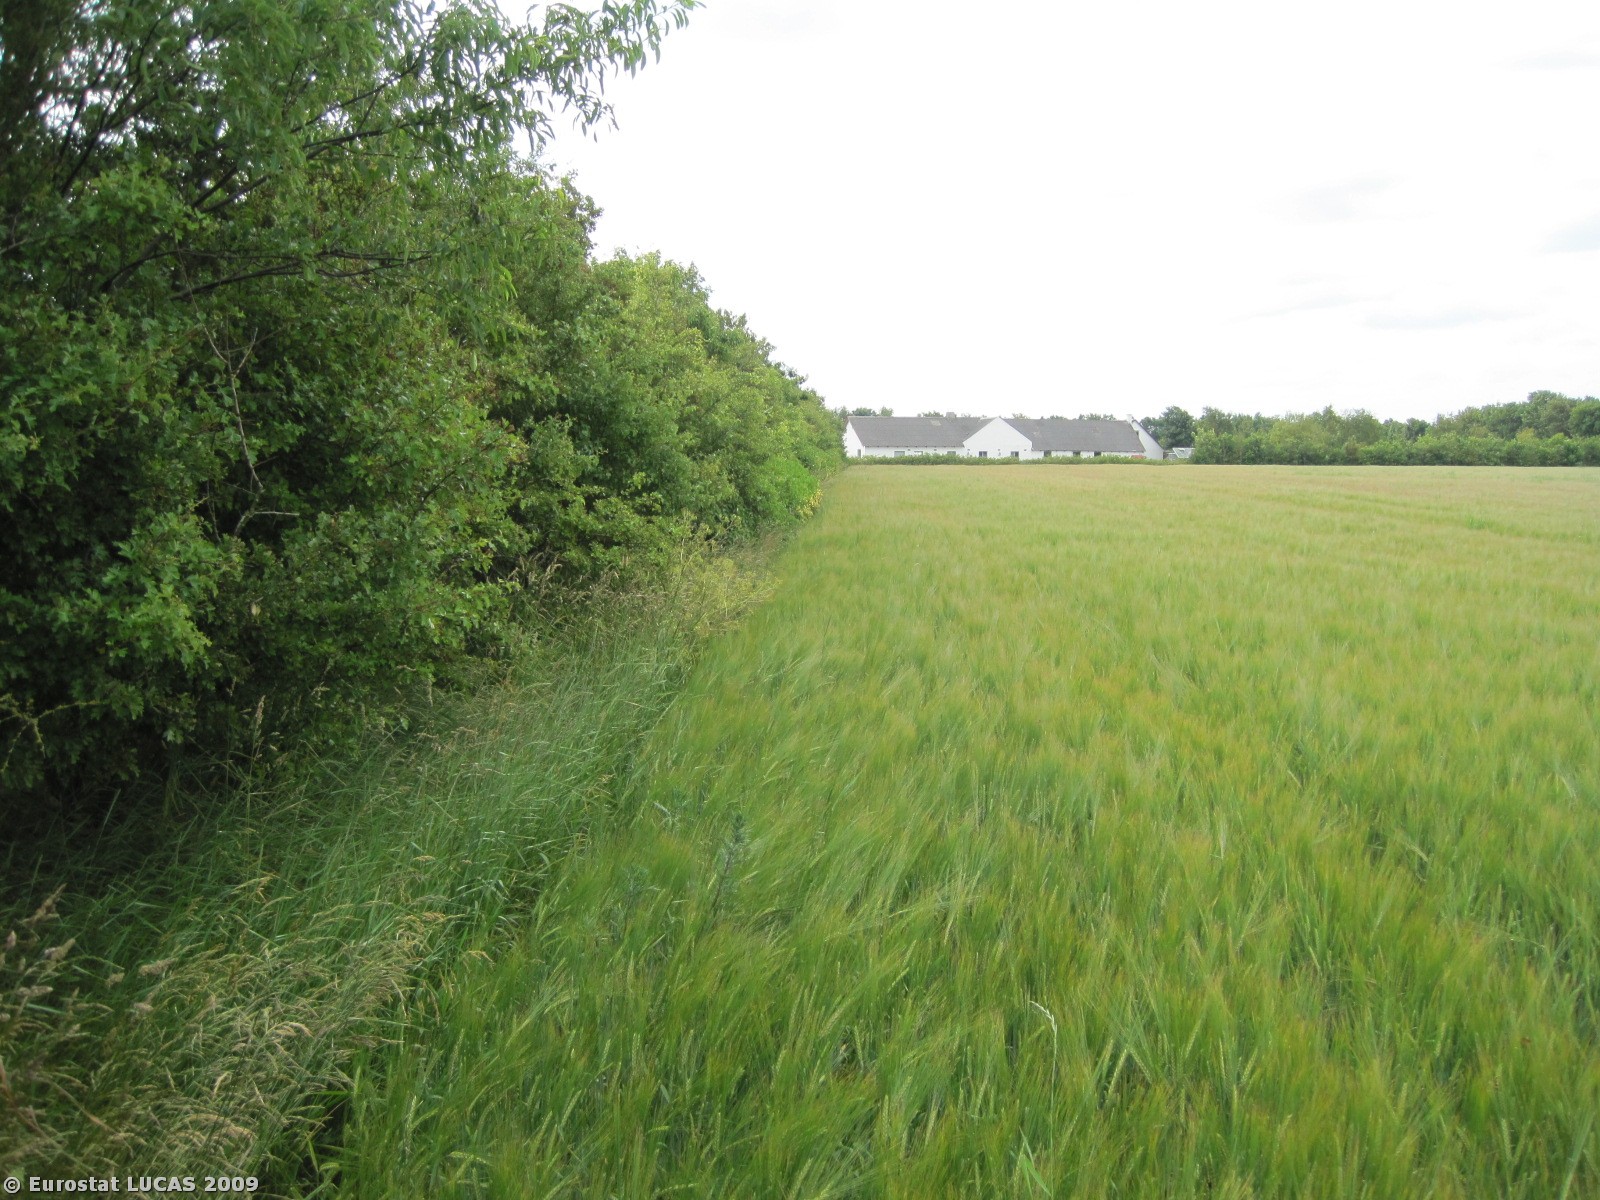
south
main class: Cropland
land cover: Barley
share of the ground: > 75 %
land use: Agriculture (excluding fallow land and kitchen gardens)
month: June
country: DK
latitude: 56.3441
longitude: 8.8204
